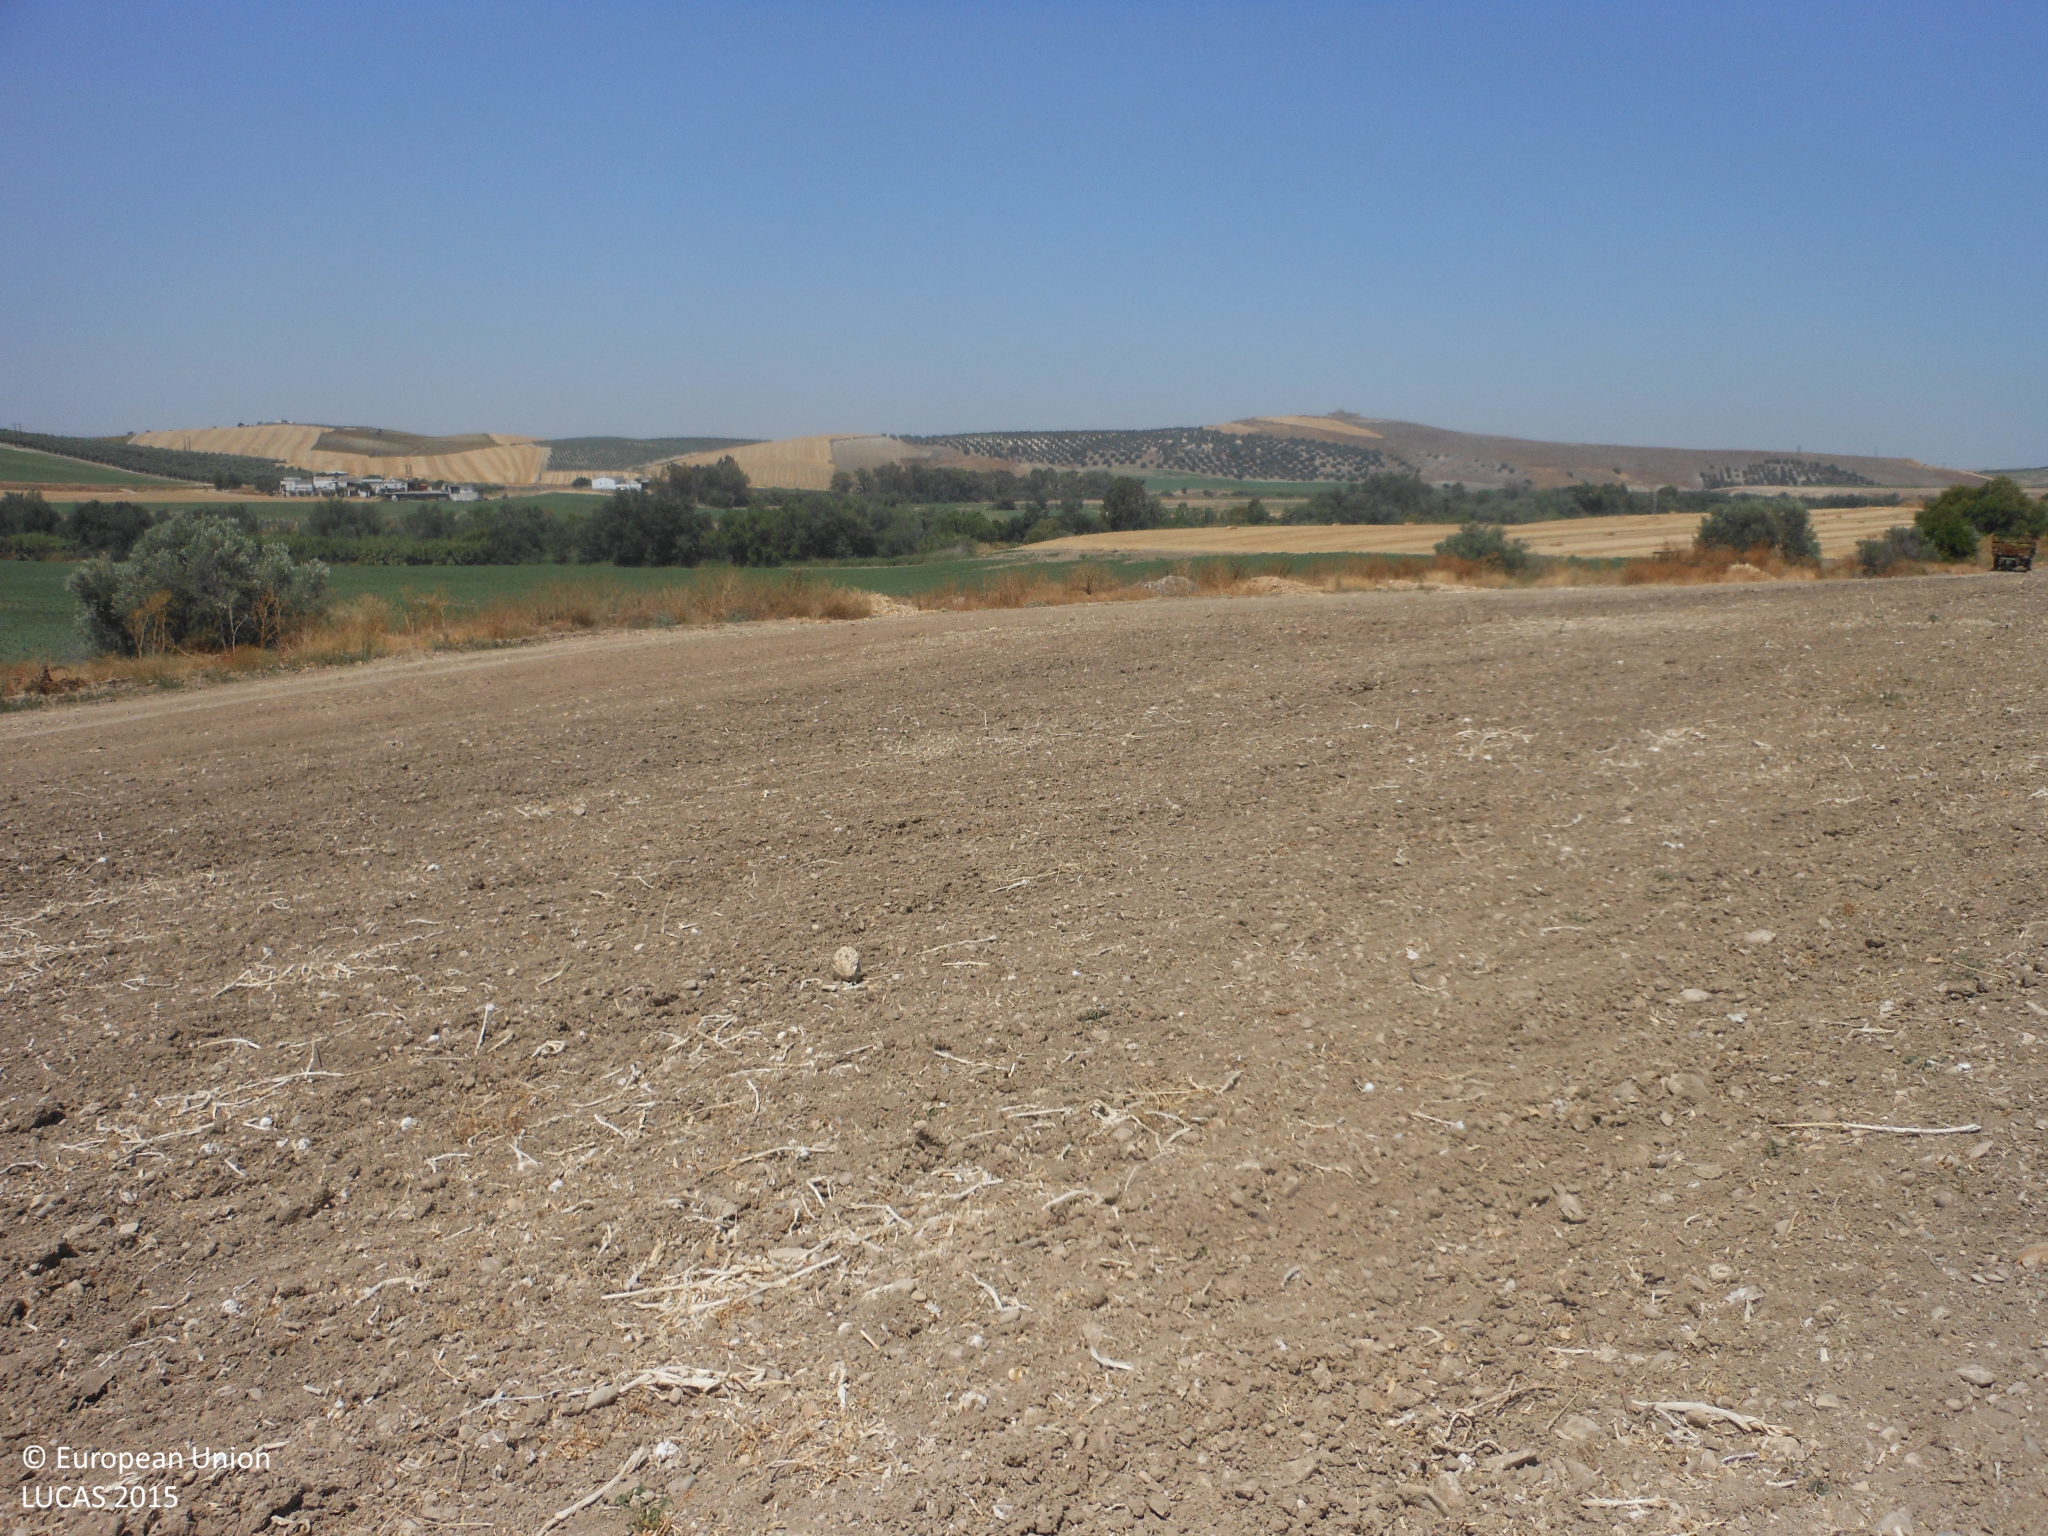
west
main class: Cropland
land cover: Other root crops
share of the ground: < 10 %
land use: Agriculture (excluding fallow land and kitchen gardens)
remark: Harvested field
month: June
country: ES
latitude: 37.4184
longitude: -4.8661
